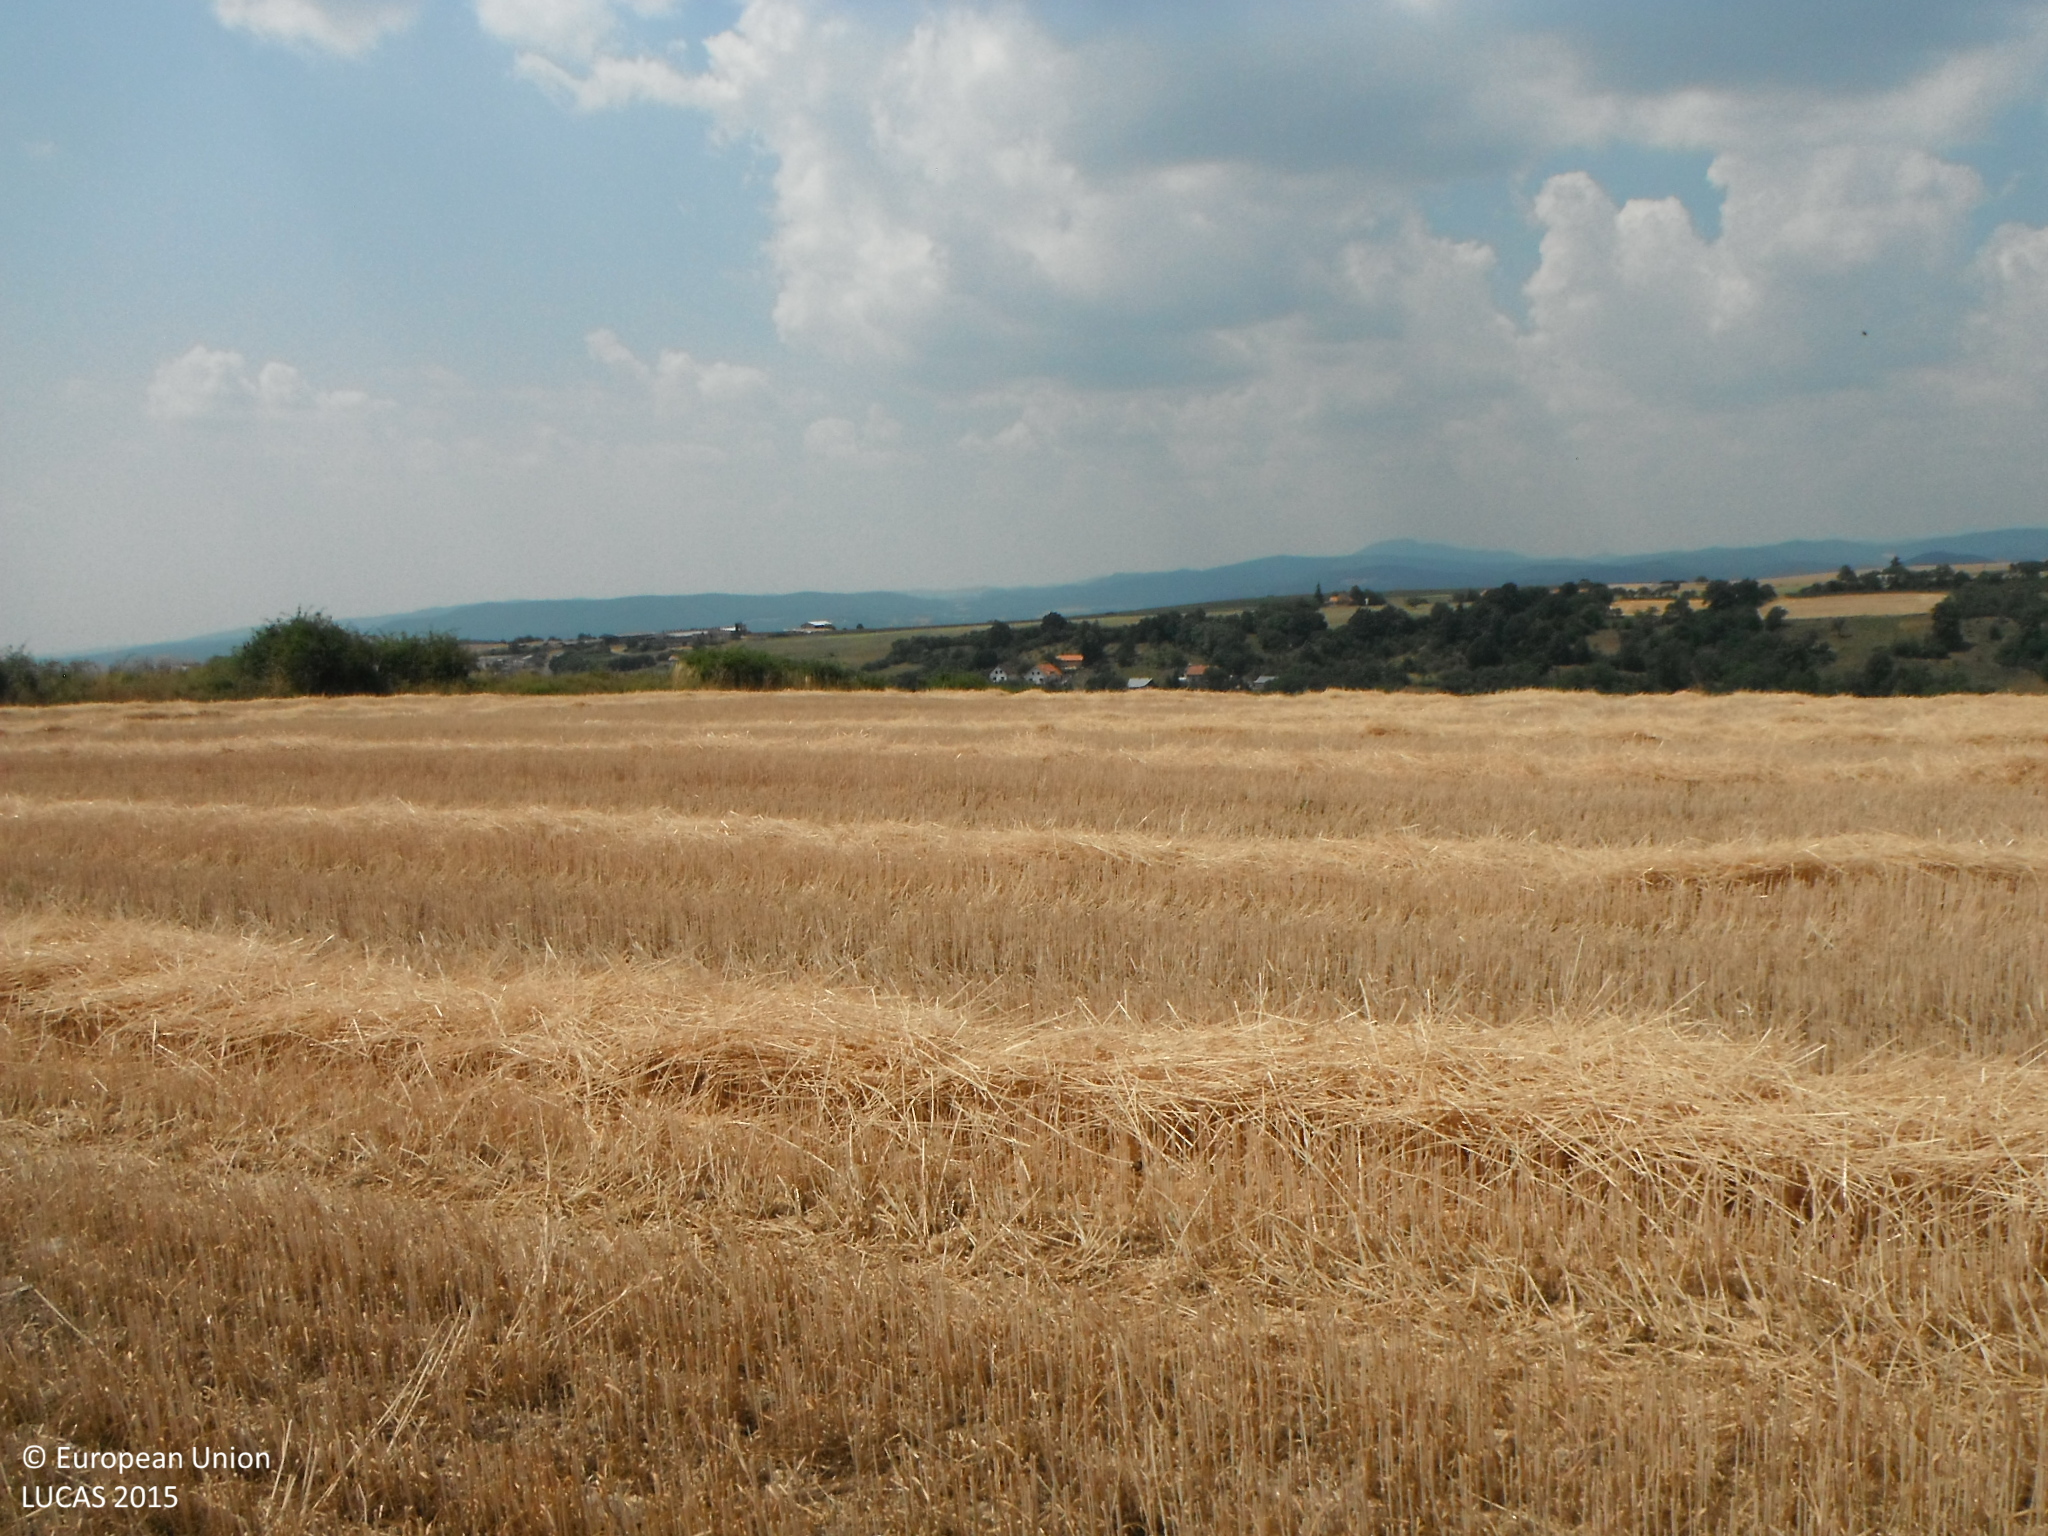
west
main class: Cropland
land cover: Common wheat
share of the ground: > 75 %
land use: Agriculture (excluding fallow land and kitchen gardens)
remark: Harvested field
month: July
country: SK
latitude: 48.3510
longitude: 19.1299
